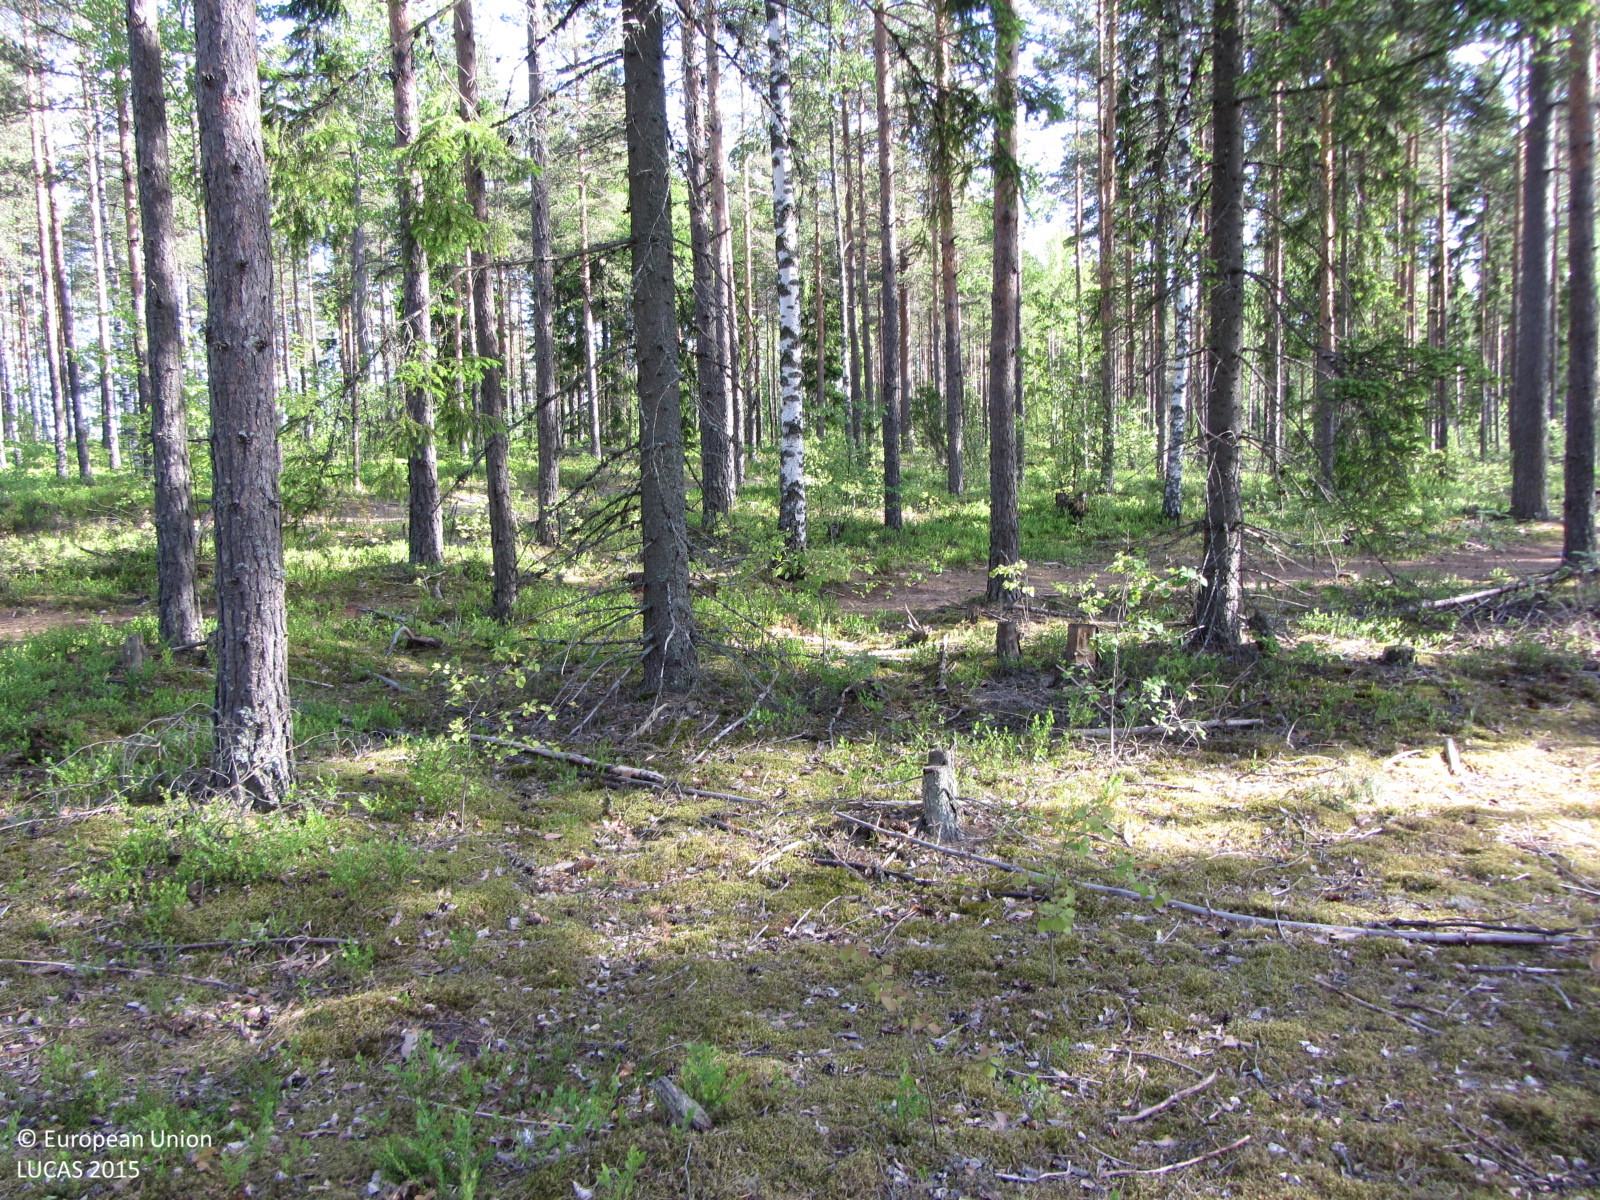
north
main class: Woodland
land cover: Other mixed woodland
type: boreal forest
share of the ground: > 75 %
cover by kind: coniferous forest trees 55 %, broadleaved forest trees 30 %, shrubs 5 %, lichens and mosses 5 %, unconsolidated bare surface 5 %
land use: Forestry
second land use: Amenities, museums, leisure
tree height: > 5 m
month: June
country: FI
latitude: 60.3288
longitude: 24.2833
